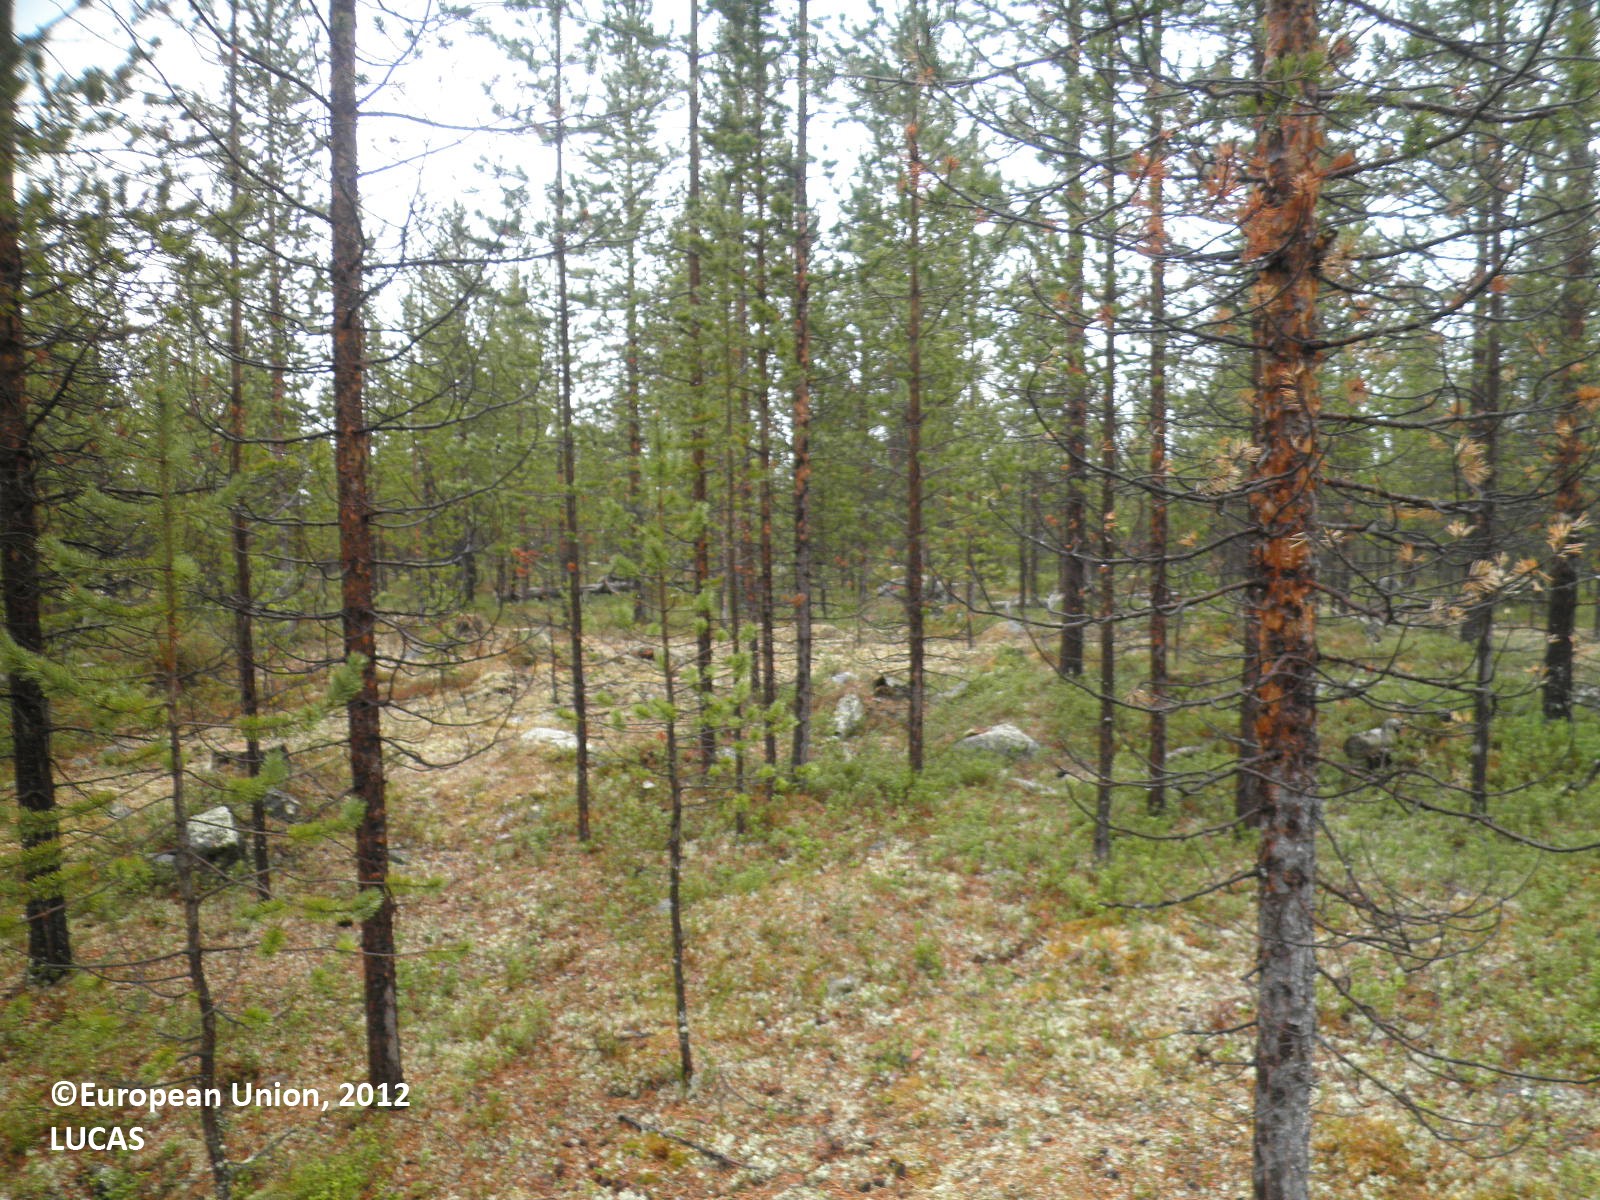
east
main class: Woodland
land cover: Pine dominated coniferous woodland
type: boreal forest
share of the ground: 50 - 75 %
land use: Forestry
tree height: > 5 m
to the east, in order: Pine dominated coniferous woodland; Inland water bodies
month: June
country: FI
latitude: 68.8978
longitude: 26.7534
